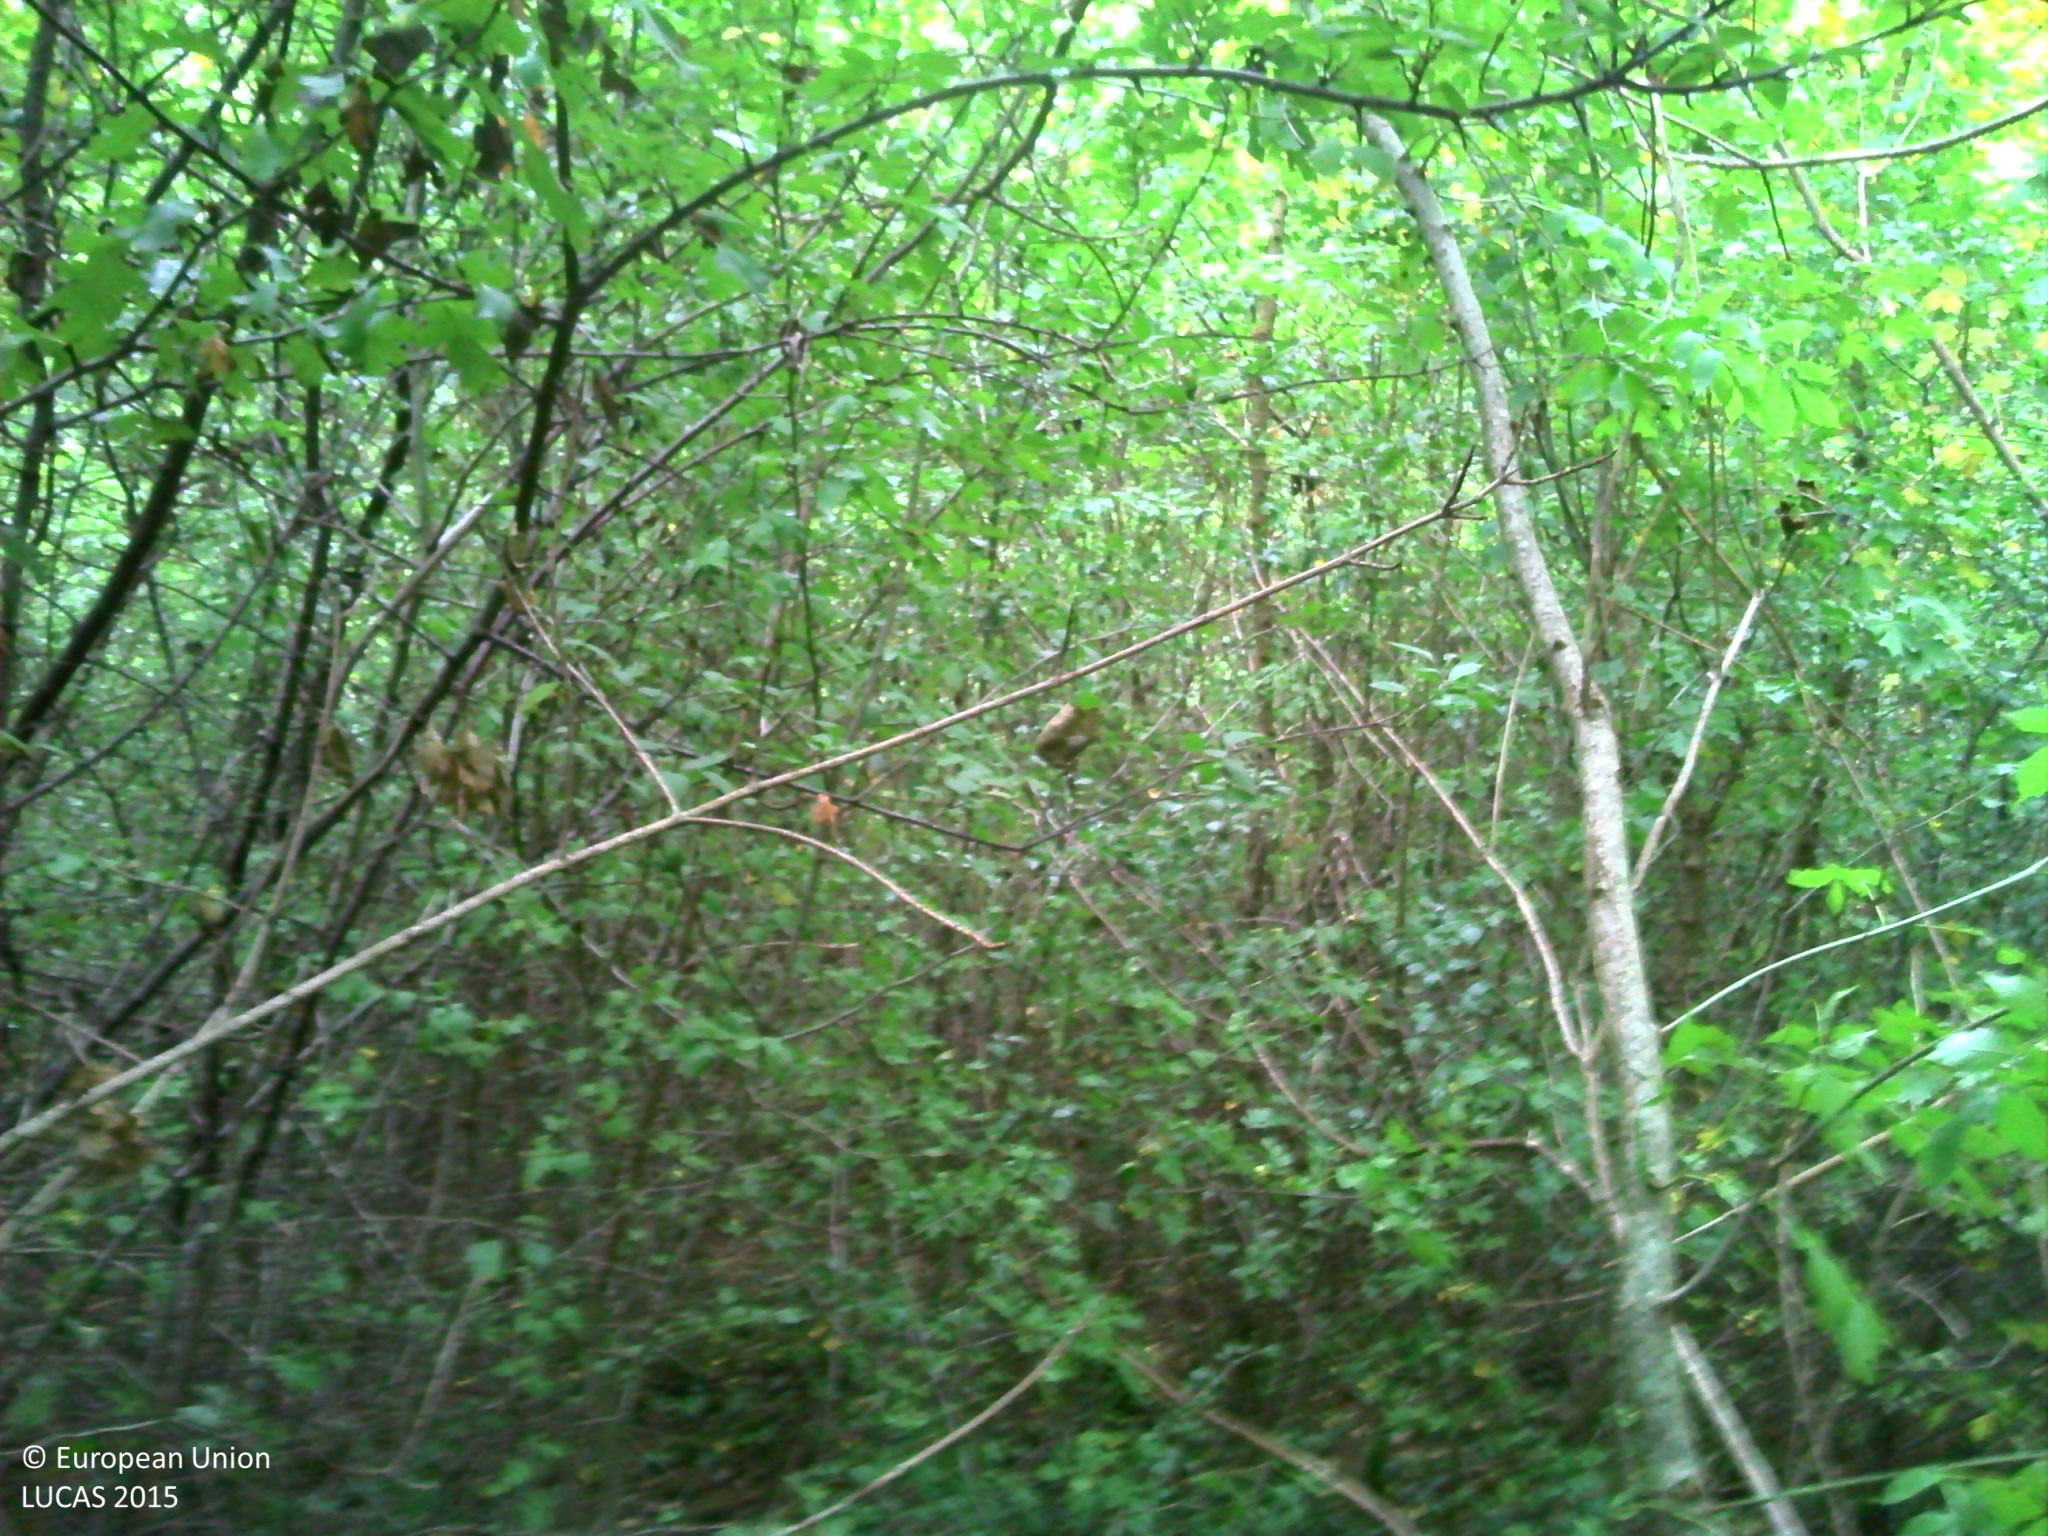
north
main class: Woodland
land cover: Broadleaved woodland
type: mesophytic deciduous forest
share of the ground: > 75 %
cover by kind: broadleaved forest trees 100 %
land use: Semi-natural and natural areas not in use
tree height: > 5 m
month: August
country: FR
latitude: 47.3792
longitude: 4.7947
